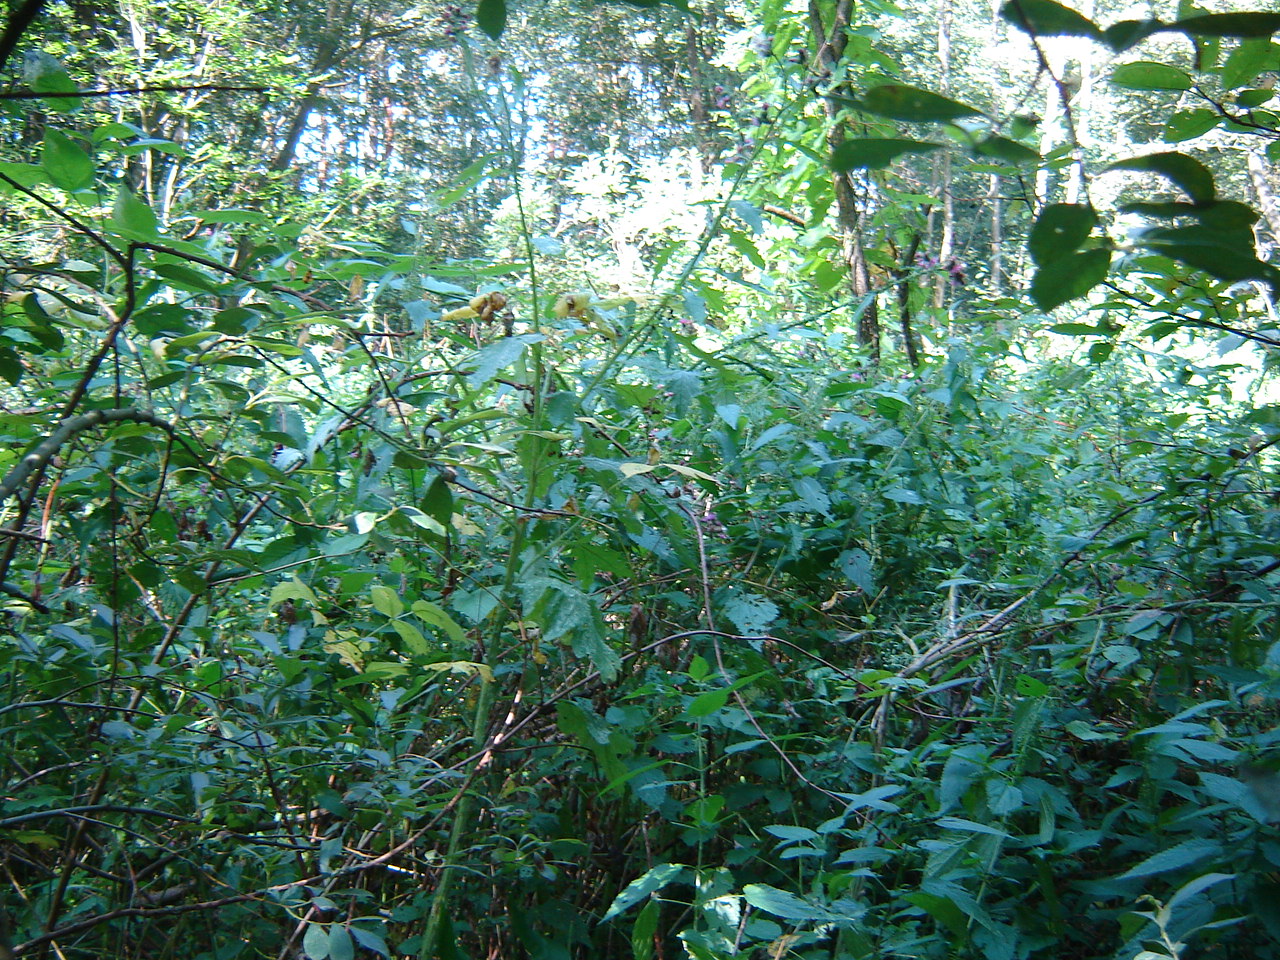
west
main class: Woodland
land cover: Broadleaved woodland
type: non-riverine alder, birch or aspen forest
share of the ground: > 75 %
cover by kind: broadleaved forest trees 85 %, herbaceous plants 15 %
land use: Forestry
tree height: > 5 m
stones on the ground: < 10 %
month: August
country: LT
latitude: 54.8400
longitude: 25.3032
